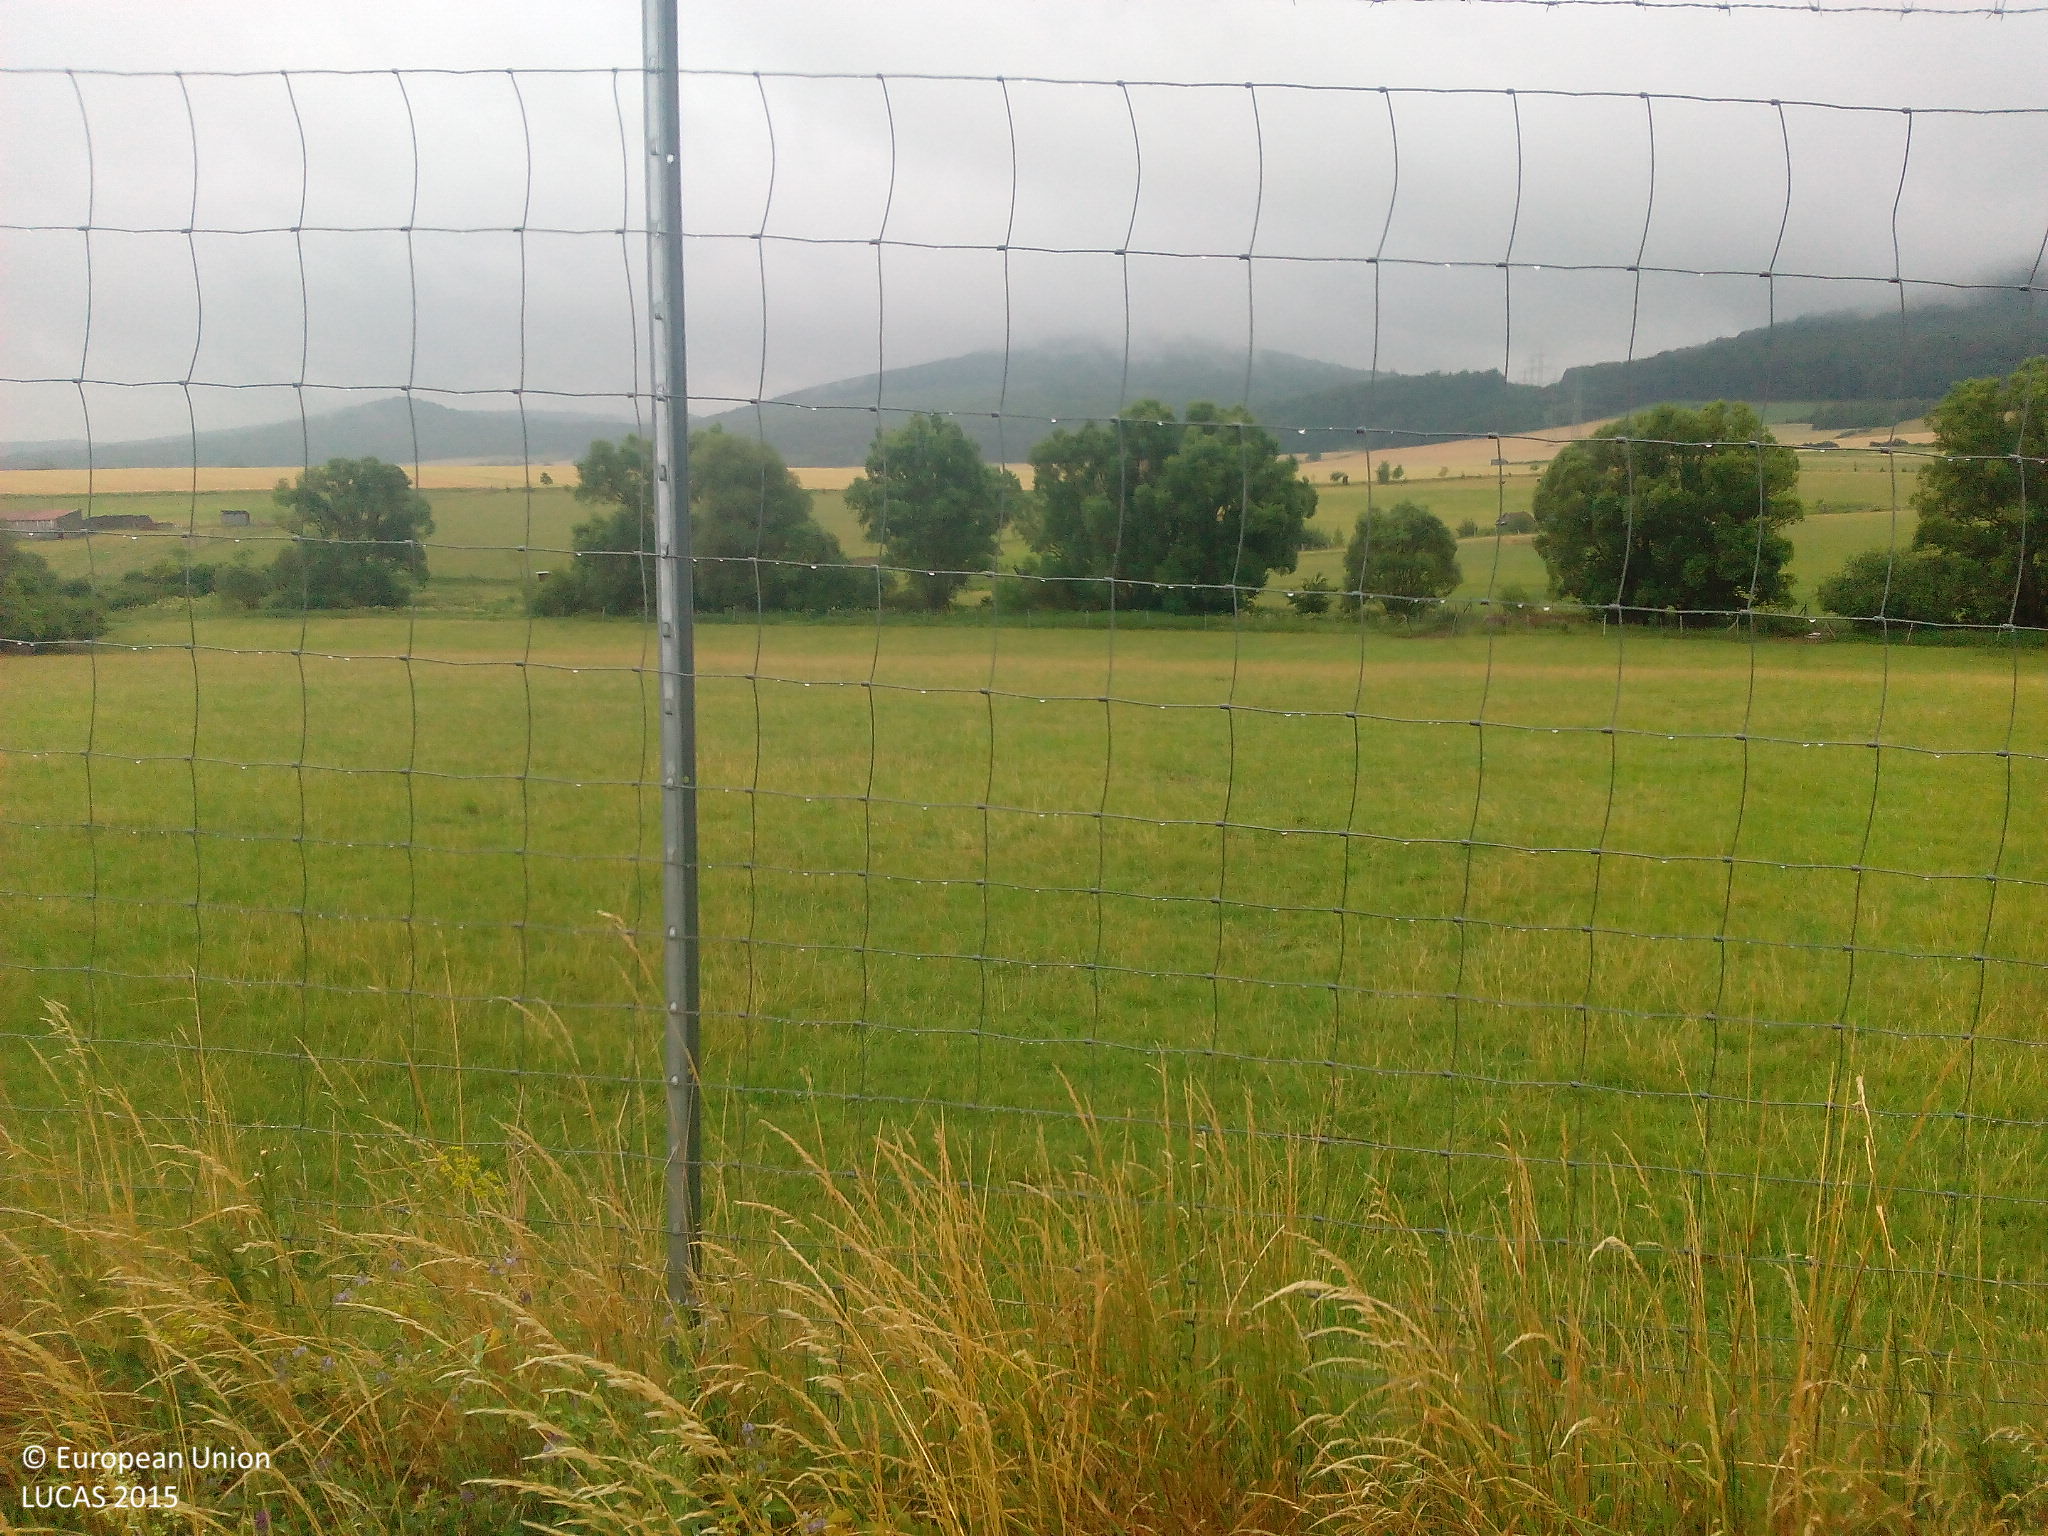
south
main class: Grassland
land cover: Grassland without tree/shrub cover
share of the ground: > 75 %
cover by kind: herbaceous plants 100 %
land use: Agriculture (excluding fallow land and kitchen gardens)
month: July
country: DE
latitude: 50.7415
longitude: 9.8442
